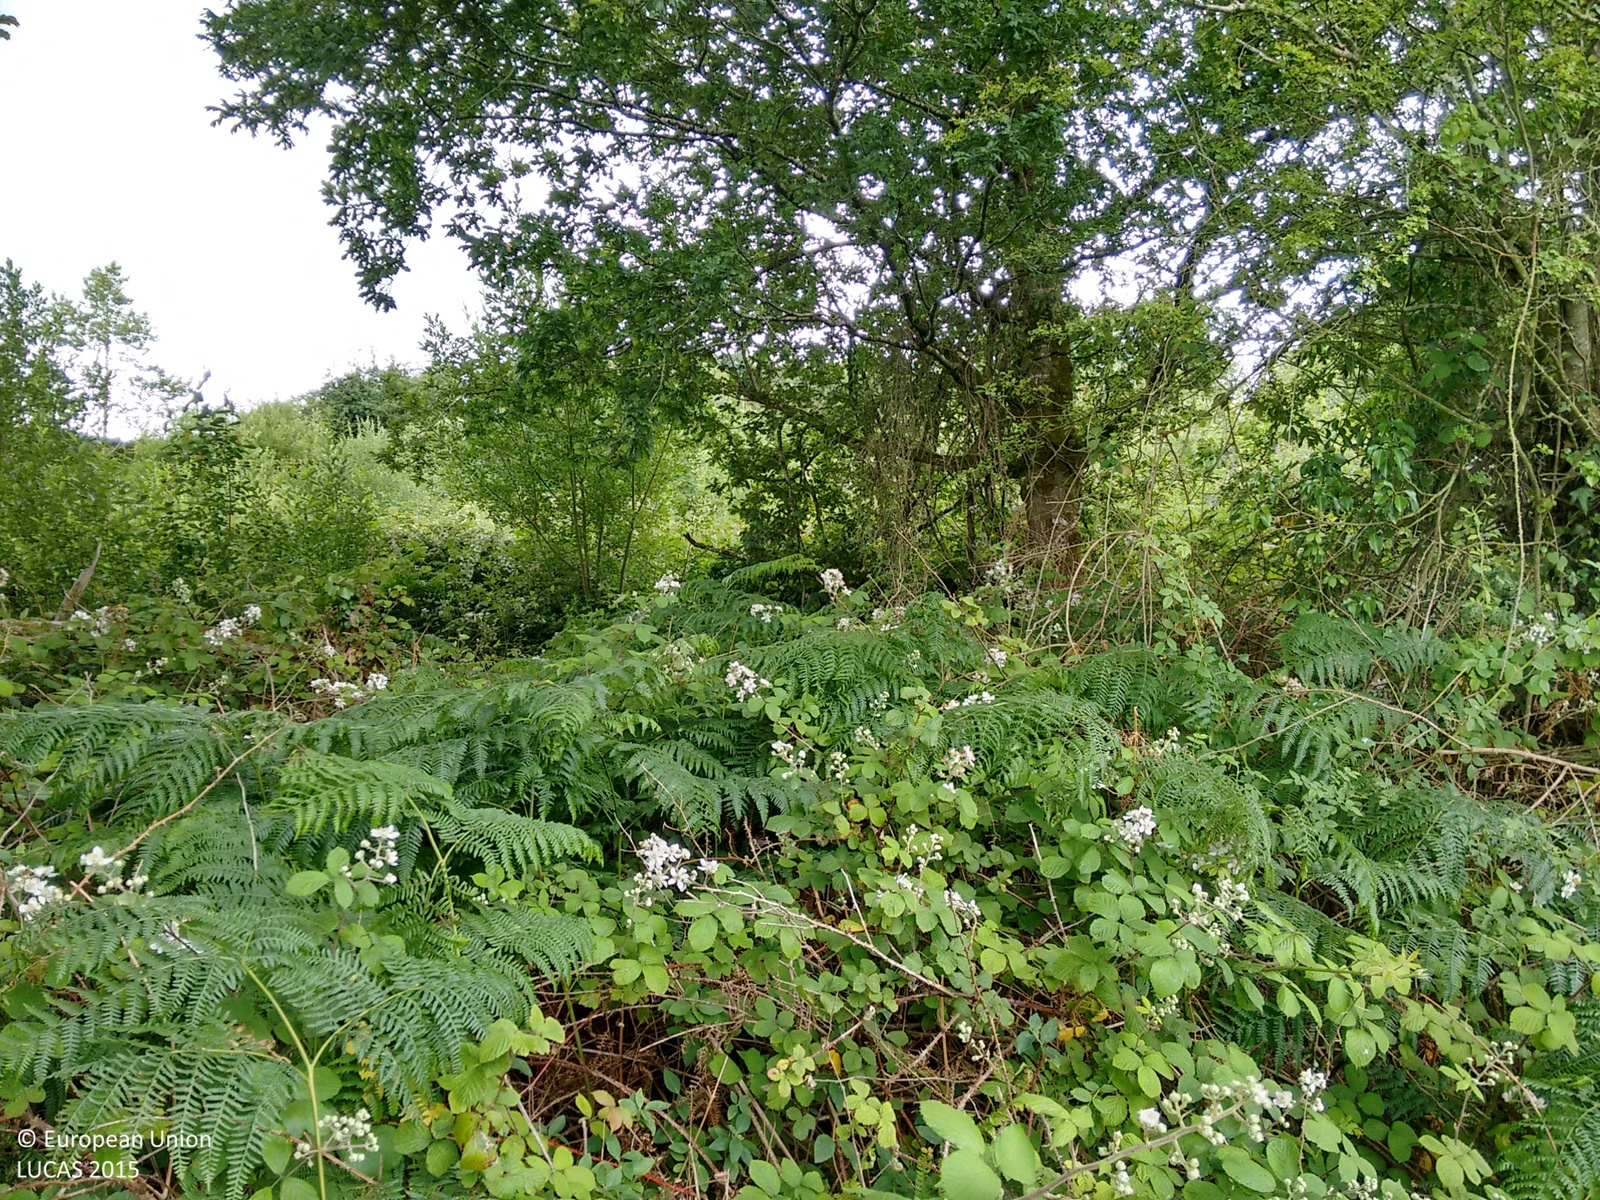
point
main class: Shrubland
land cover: Shrubland with sparse tree cover
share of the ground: > 75 %
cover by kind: shrubs 70 %, herbaceous plants 15 %, lichens and mosses 10 %, broadleaved forest trees 5 %
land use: Semi-natural and natural areas not in use
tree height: > 5 m
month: July
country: IE
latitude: 52.8798
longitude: -8.3925
